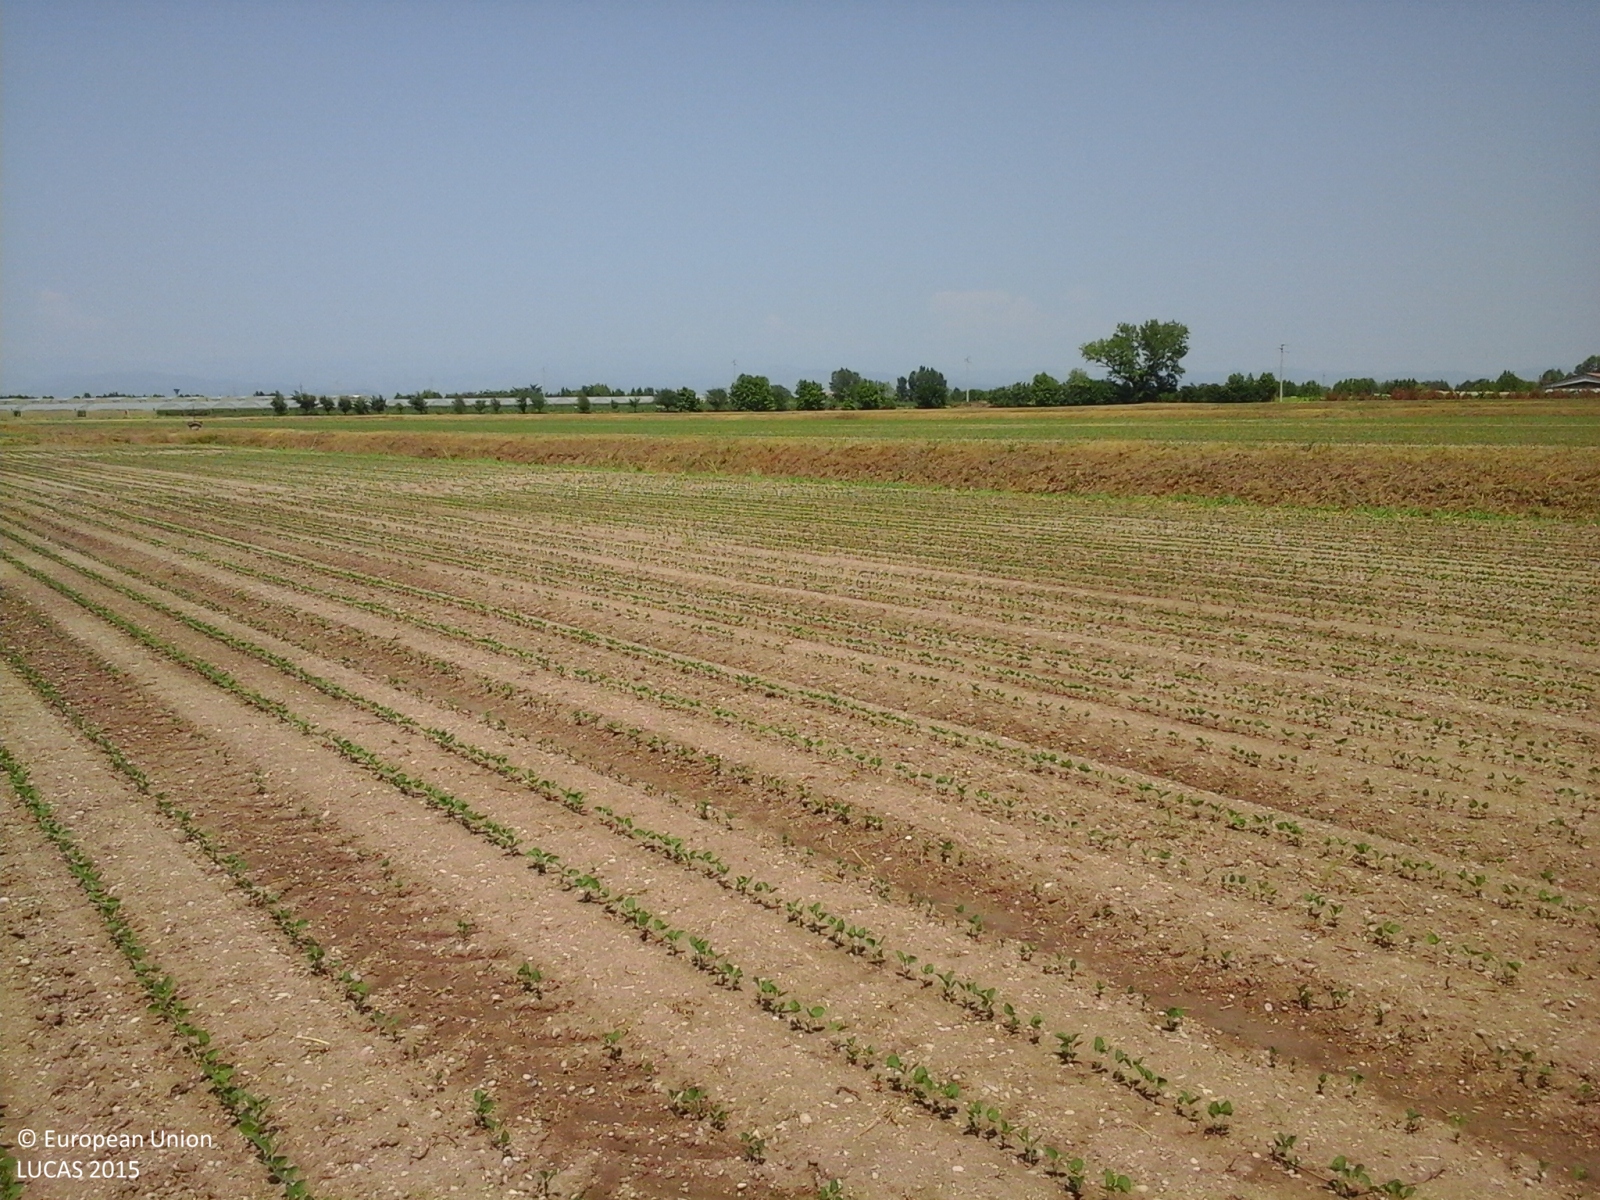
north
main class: Cropland
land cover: Soya
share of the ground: < 10 %
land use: Agriculture (excluding fallow land and kitchen gardens)
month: July
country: IT
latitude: 45.3196
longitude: 10.9805
